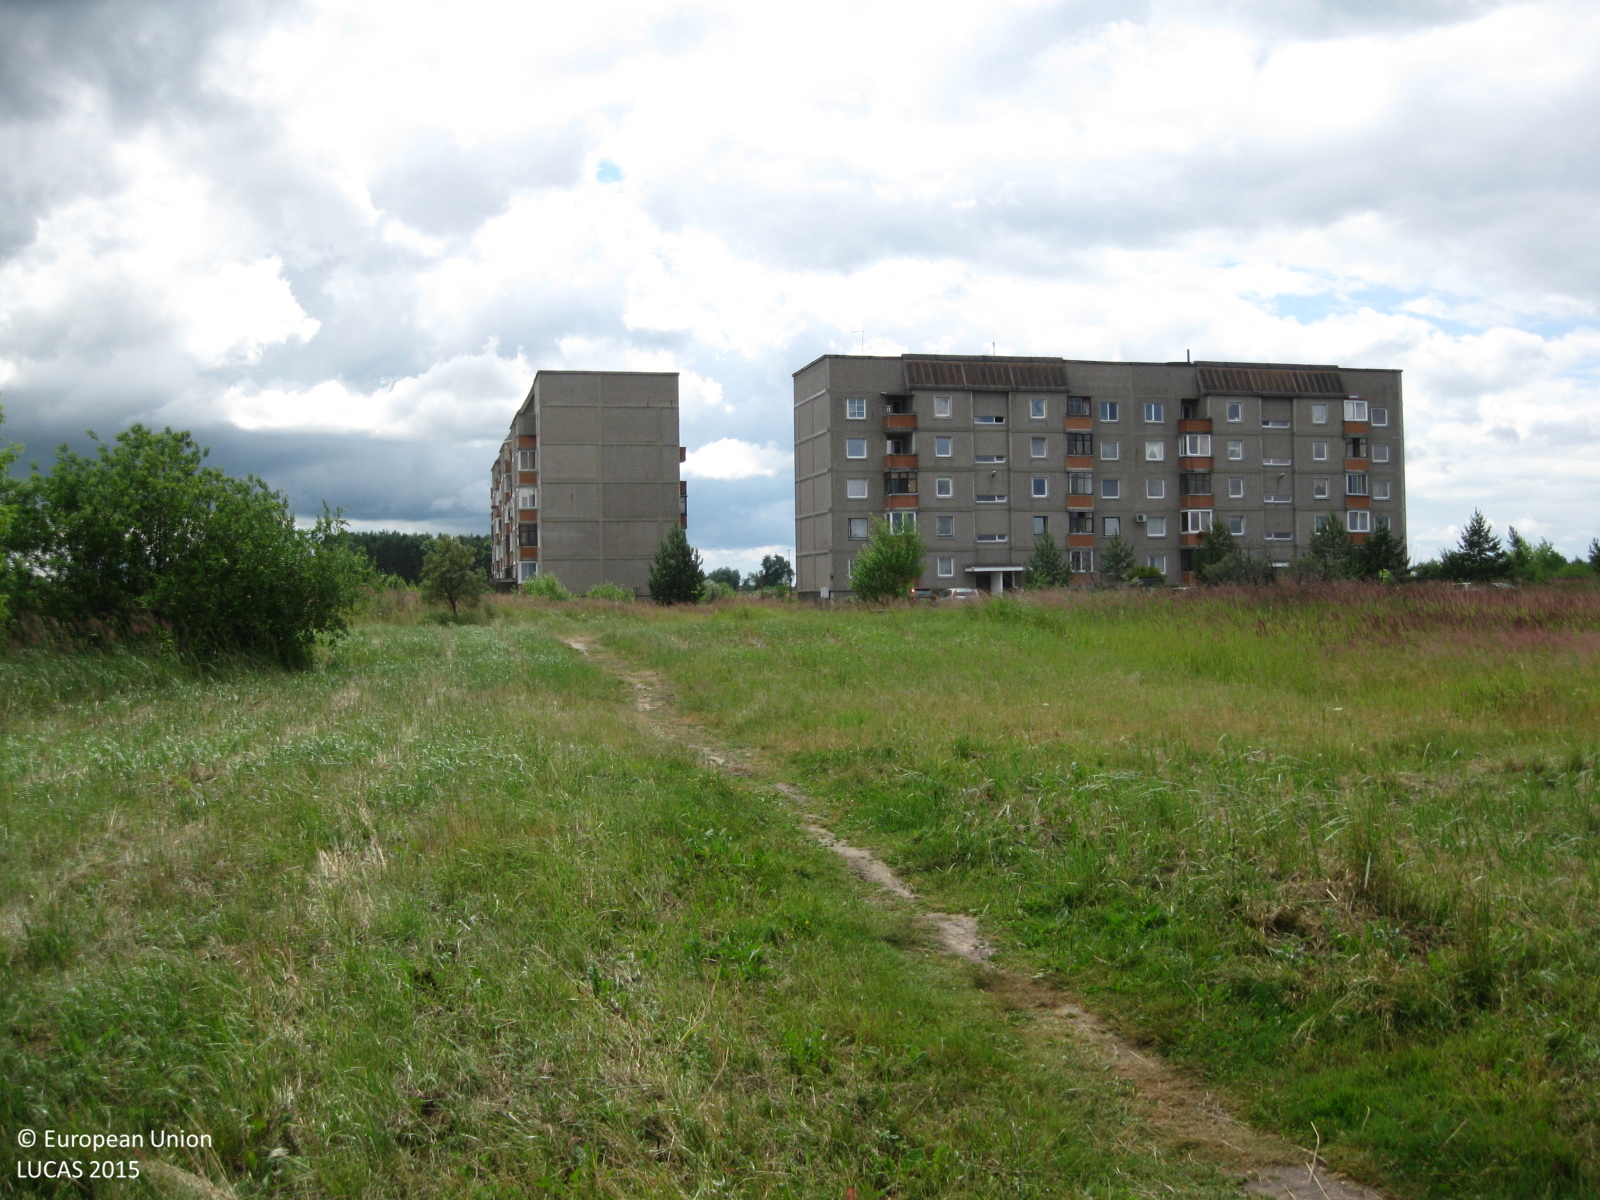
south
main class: Grassland
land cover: Grassland with sparse tree/shrub cover
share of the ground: > 75 %
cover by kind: herbaceous plants 90 %, broadleaved forest trees 5 %, shrubs 5 %
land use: Amenities, museums, leisure
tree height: > 5 m
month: July
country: LT
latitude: 55.7270
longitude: 24.3139
